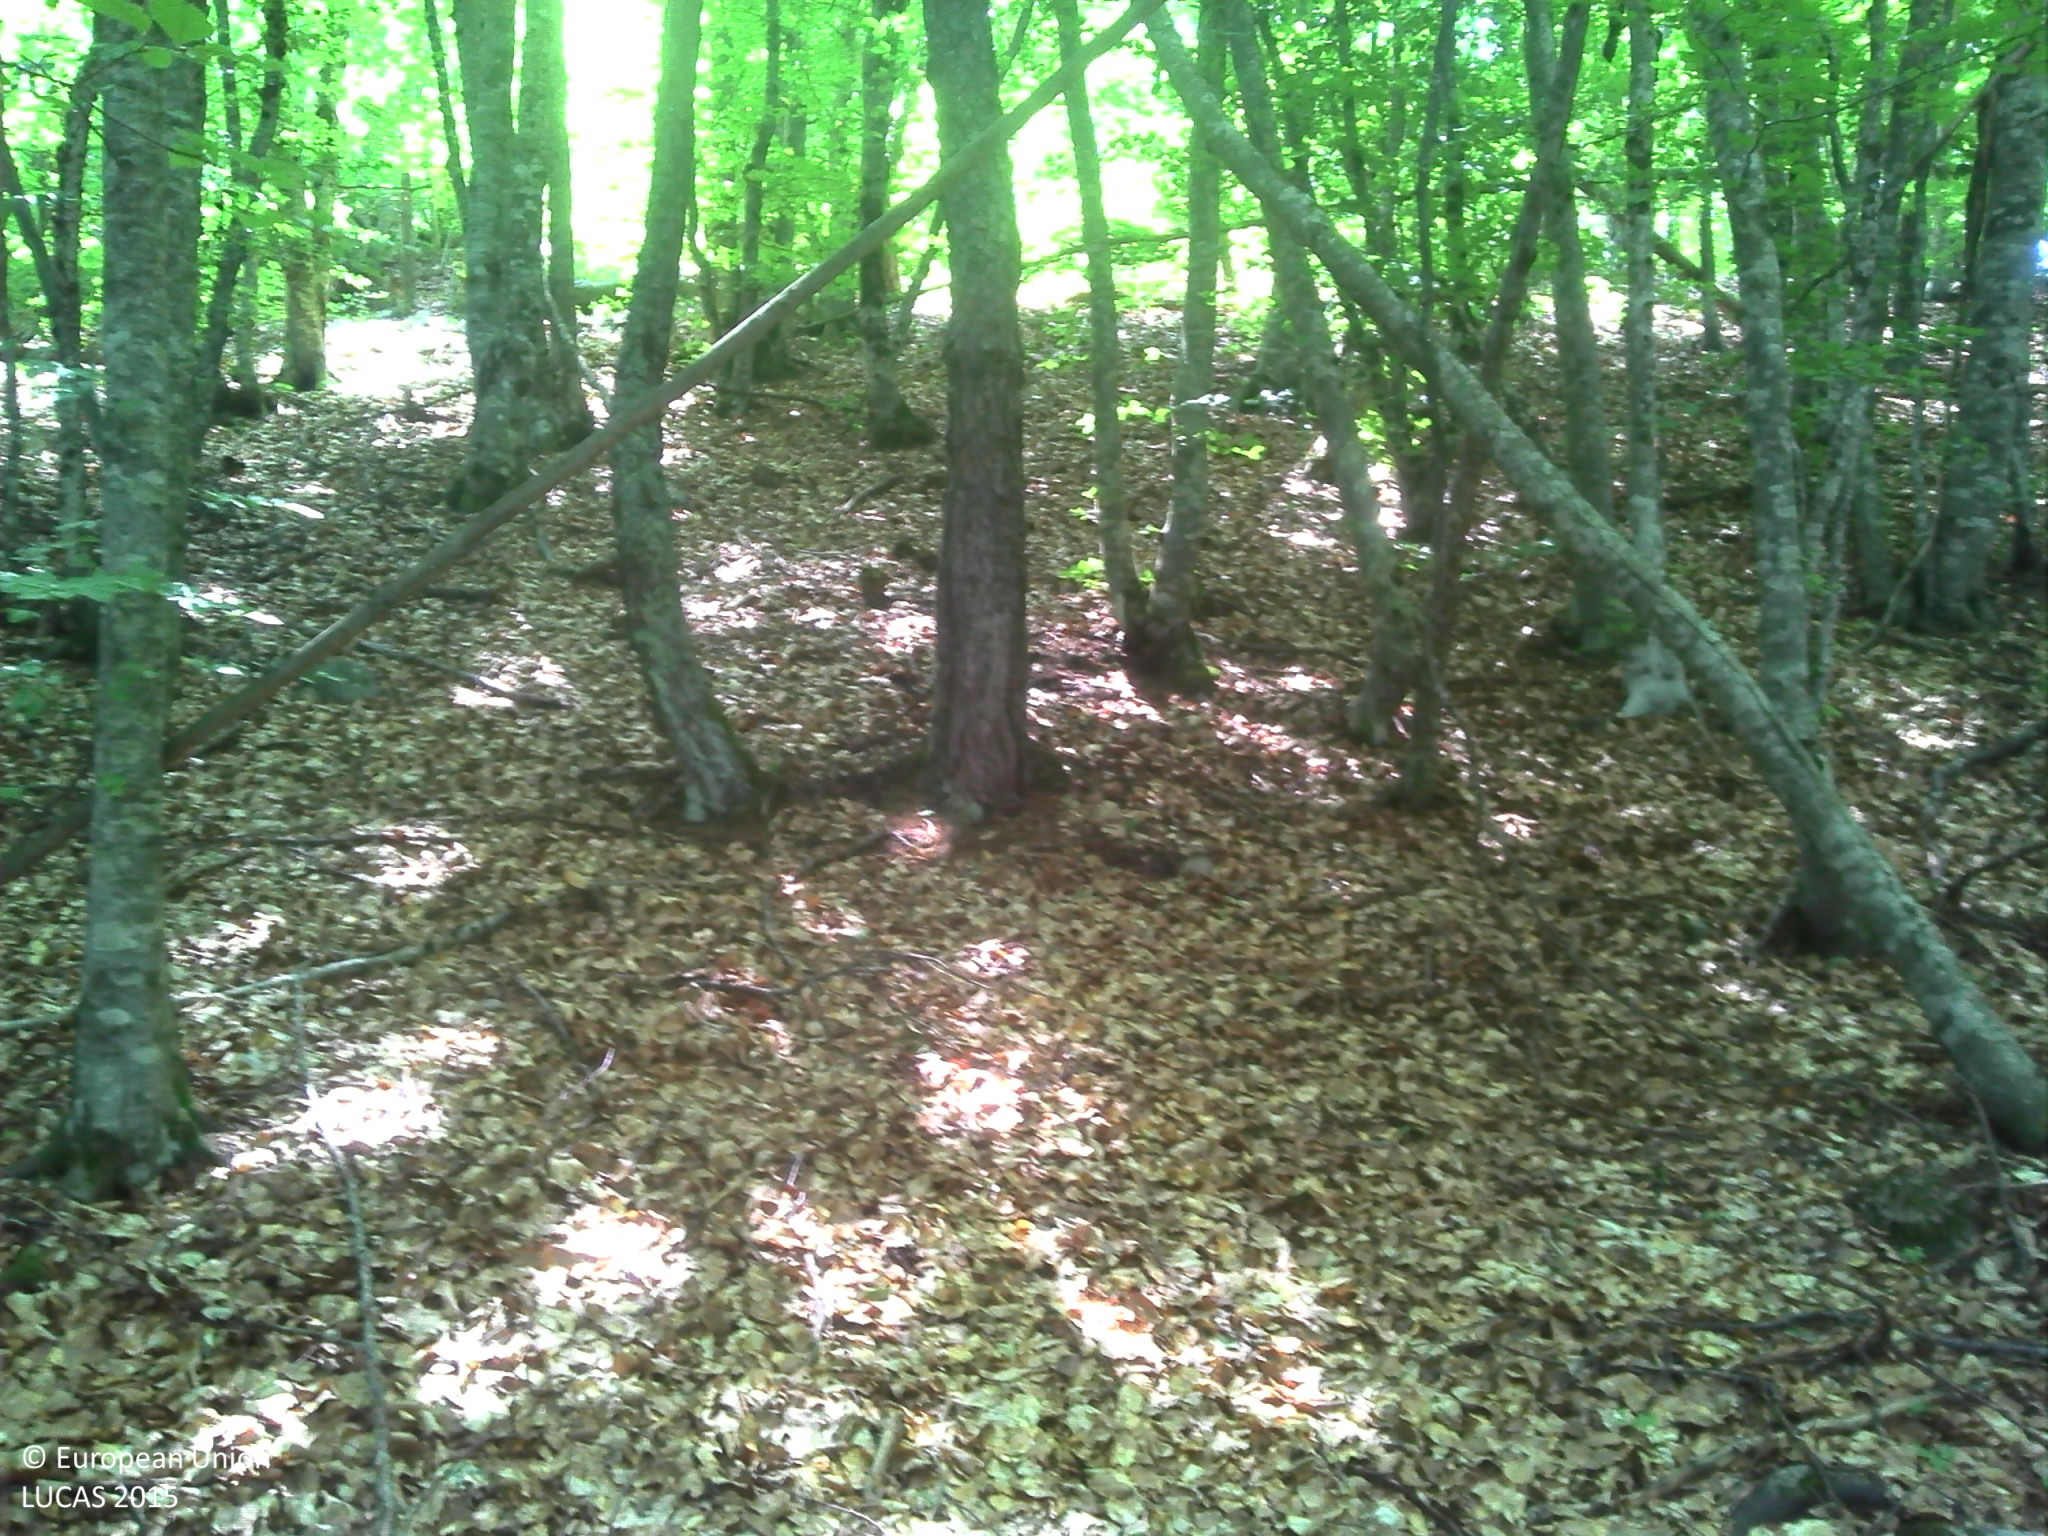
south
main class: Woodland
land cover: Broadleaved woodland
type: beech forest
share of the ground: > 75 %
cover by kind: broadleaved forest trees 85 %, shrubs 5 %, herbaceous plants 5 %, lichens and mosses 5 %
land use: Forestry
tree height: > 5 m
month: July
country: FR
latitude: 44.4291
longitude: 6.3010
